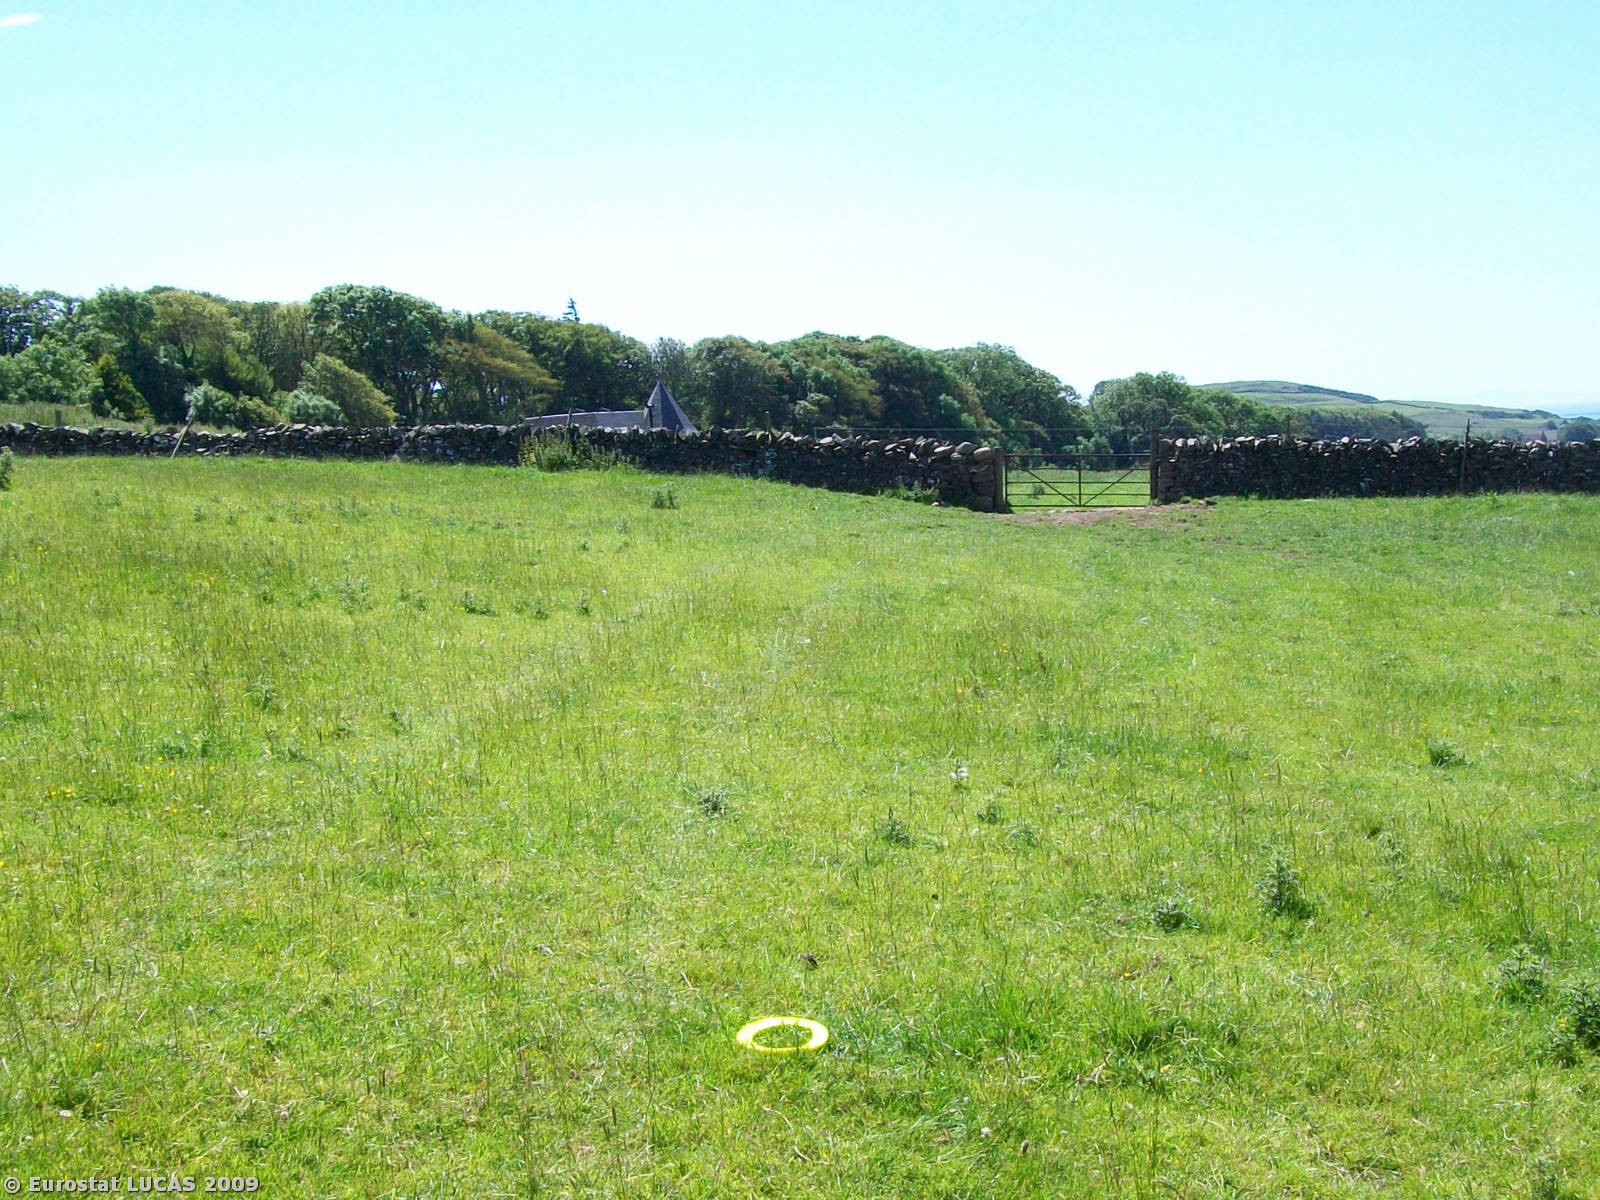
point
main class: Grassland
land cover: Grassland without tree/shrub cover
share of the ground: > 75 %
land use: Agriculture (excluding fallow land and kitchen gardens)
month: June
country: GB
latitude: 54.7994
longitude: -4.1091
